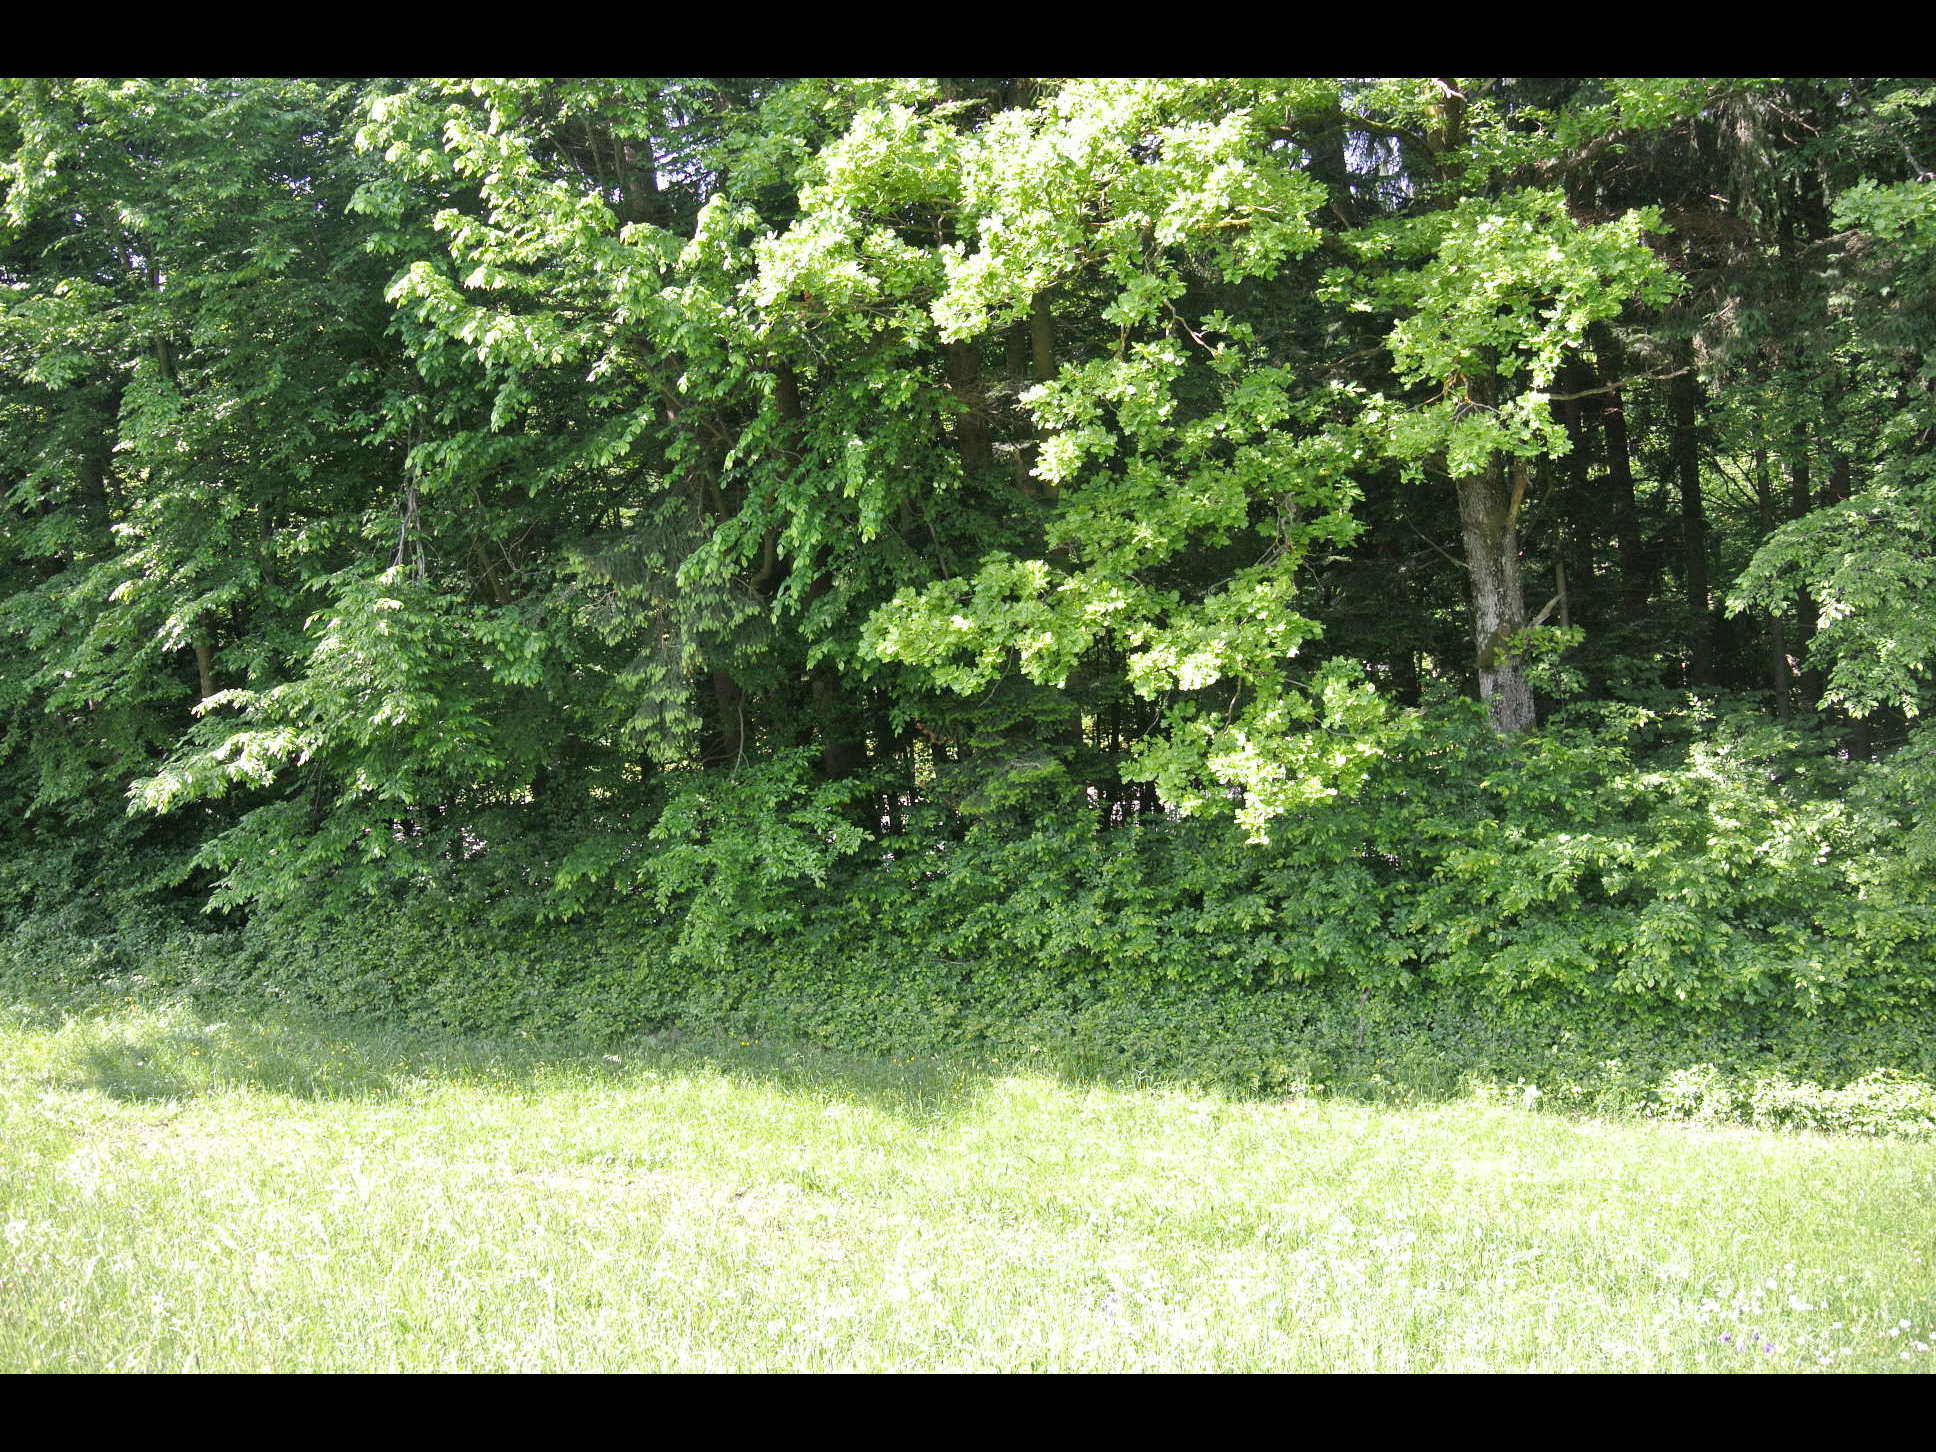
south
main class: Grassland
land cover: Grassland without tree/shrub cover
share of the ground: > 75 %
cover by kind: herbaceous plants 100 %
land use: Agriculture (excluding fallow land and kitchen gardens)
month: May
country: AT
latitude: 48.0328
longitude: 15.8367
